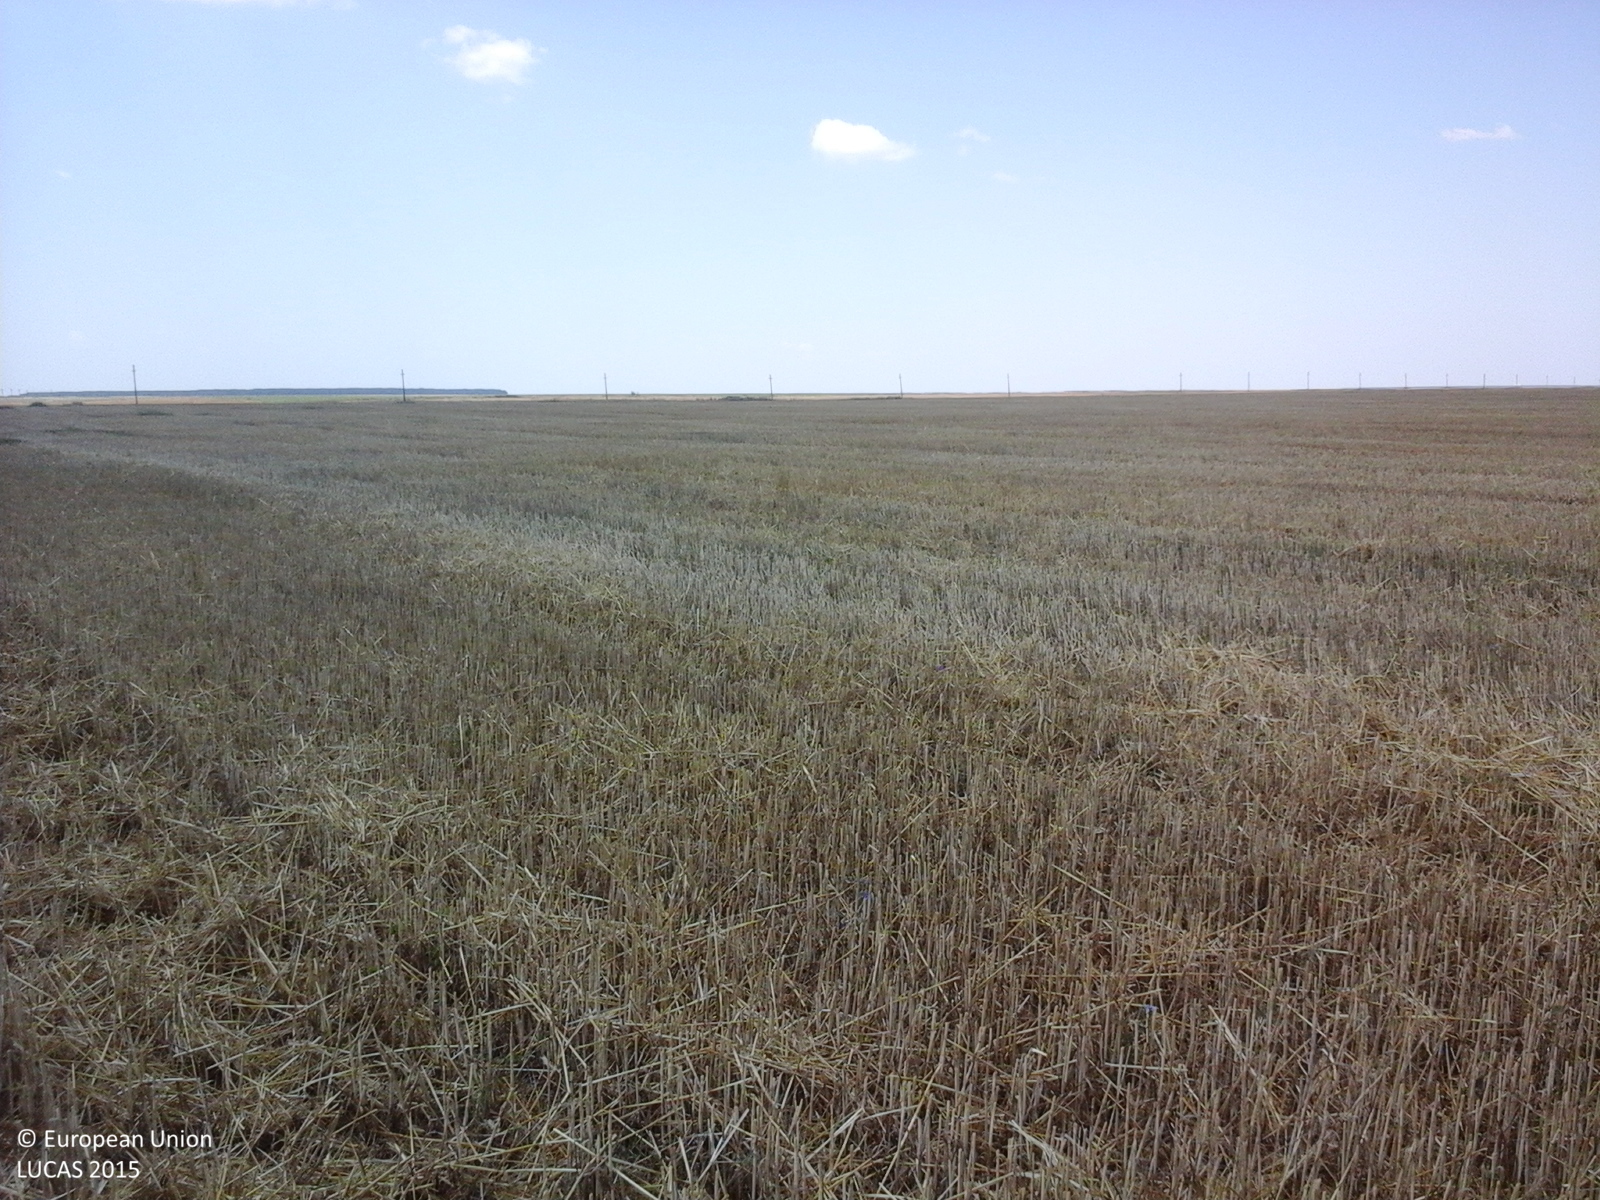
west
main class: Cropland
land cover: Common wheat
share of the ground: 50 - 75 %
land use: Agriculture (excluding fallow land and kitchen gardens)
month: July
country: RO
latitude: 44.2048
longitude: 24.6246
